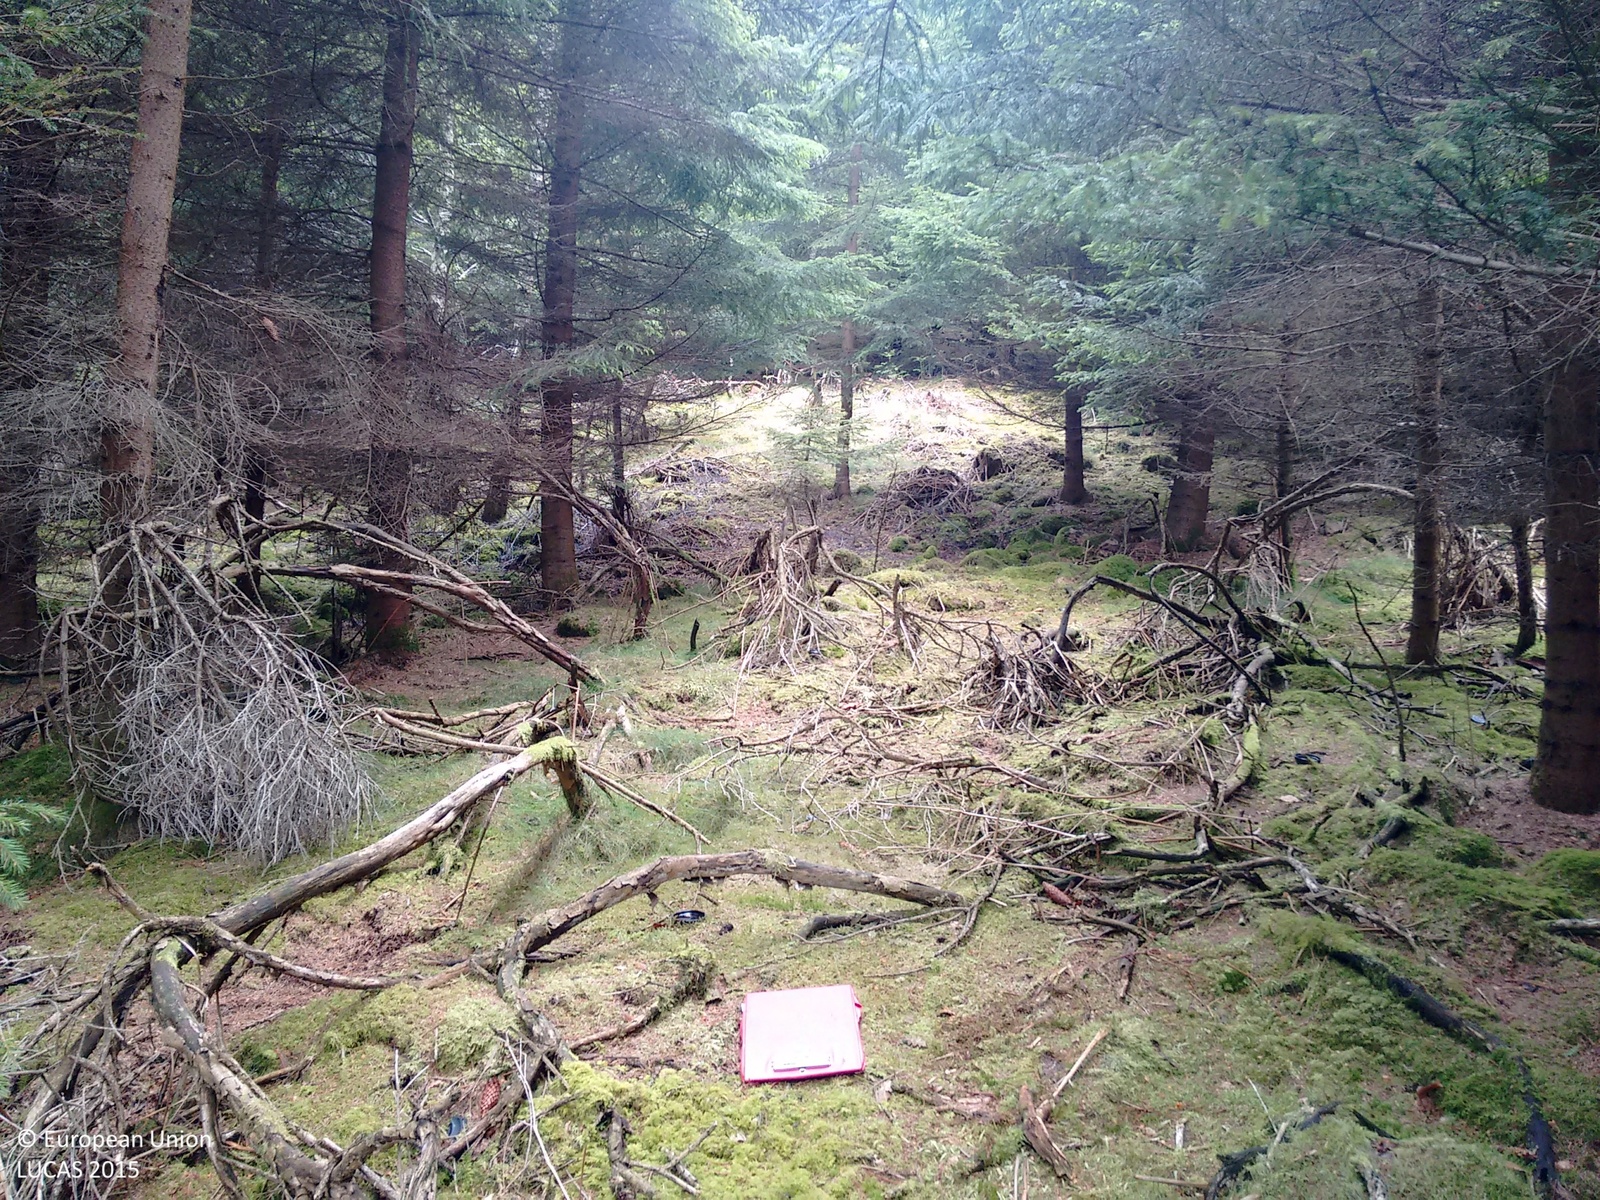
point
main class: Woodland
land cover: Spruce dominated coniferous woodland
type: exotic forest
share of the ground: > 75 %
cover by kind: coniferous forest trees 95 %, lichens and mosses 5 %
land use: Forestry
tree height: > 5 m
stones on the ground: < 10 %
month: June
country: GB
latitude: 57.0981
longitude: -2.7521
